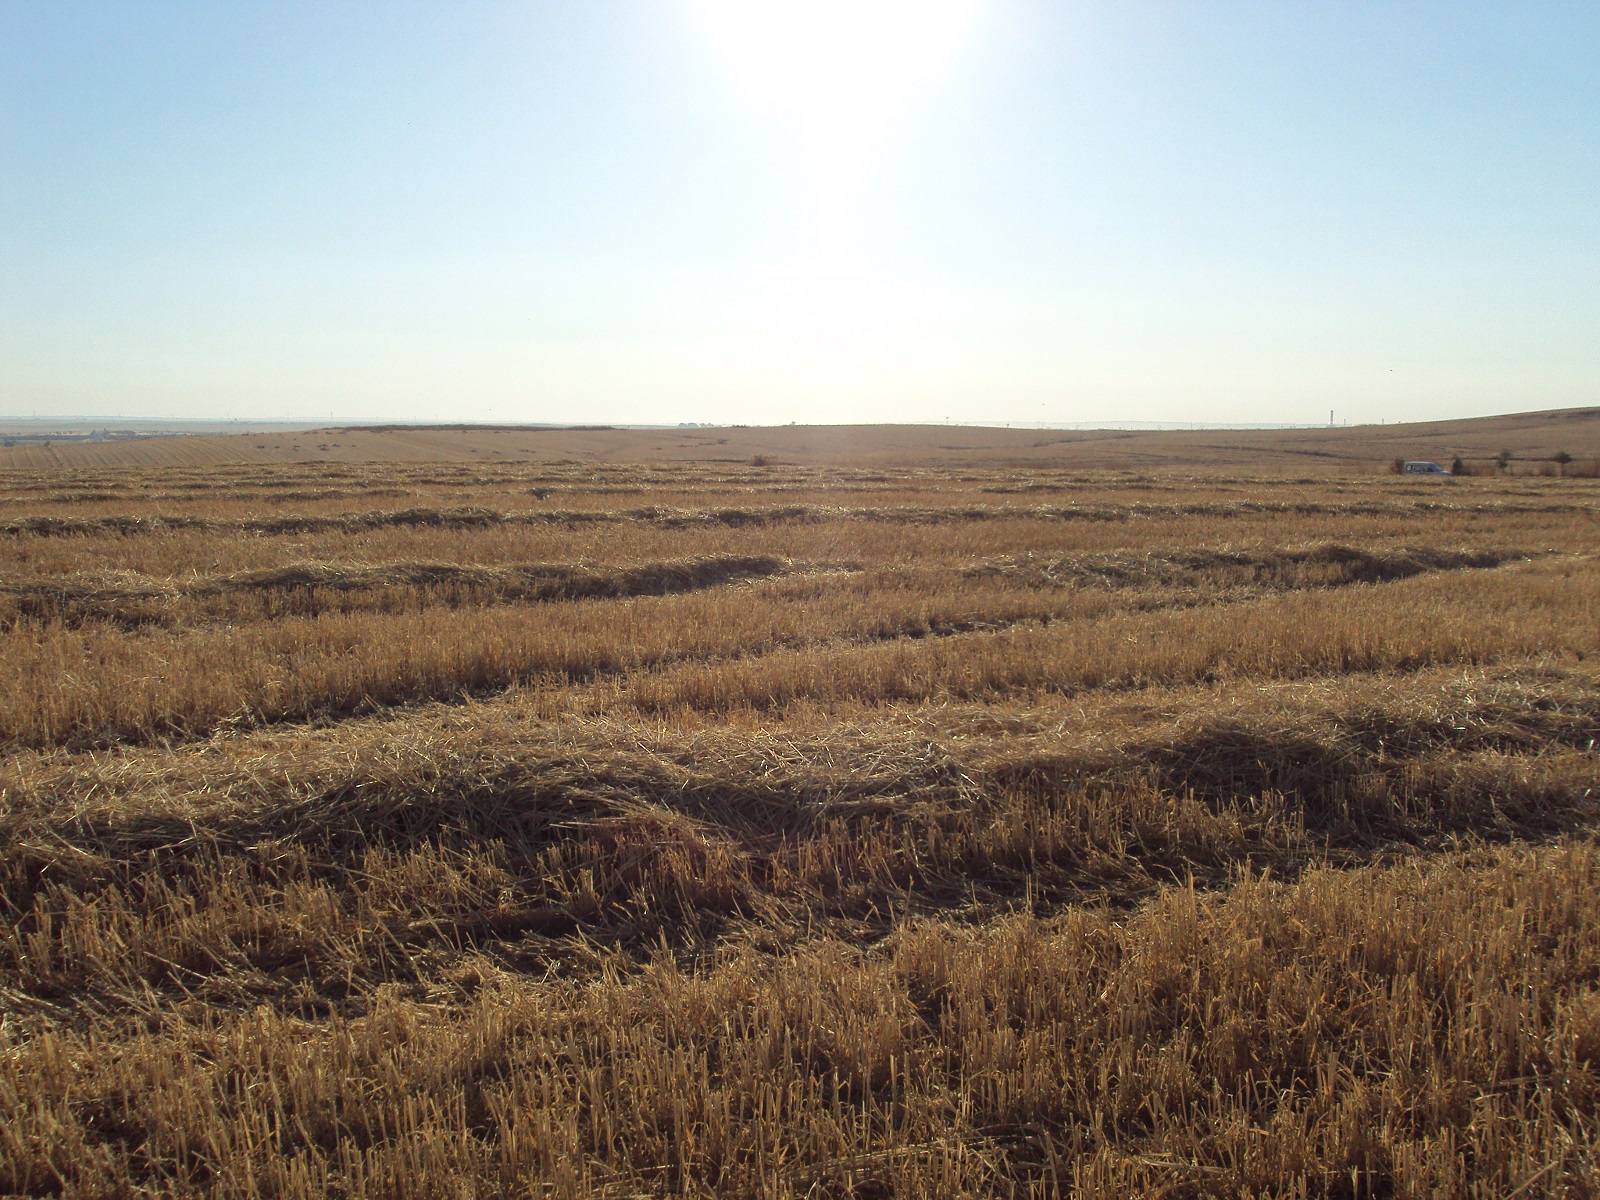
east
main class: Cropland
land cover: Durum wheat
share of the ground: > 75 %
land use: Agriculture (excluding fallow land and kitchen gardens)
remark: Harvested field
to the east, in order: Durum wheat; Grass margins; Tracks; Grass margins; Durum wheat
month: June
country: ES
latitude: 37.3077
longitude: -6.9290
